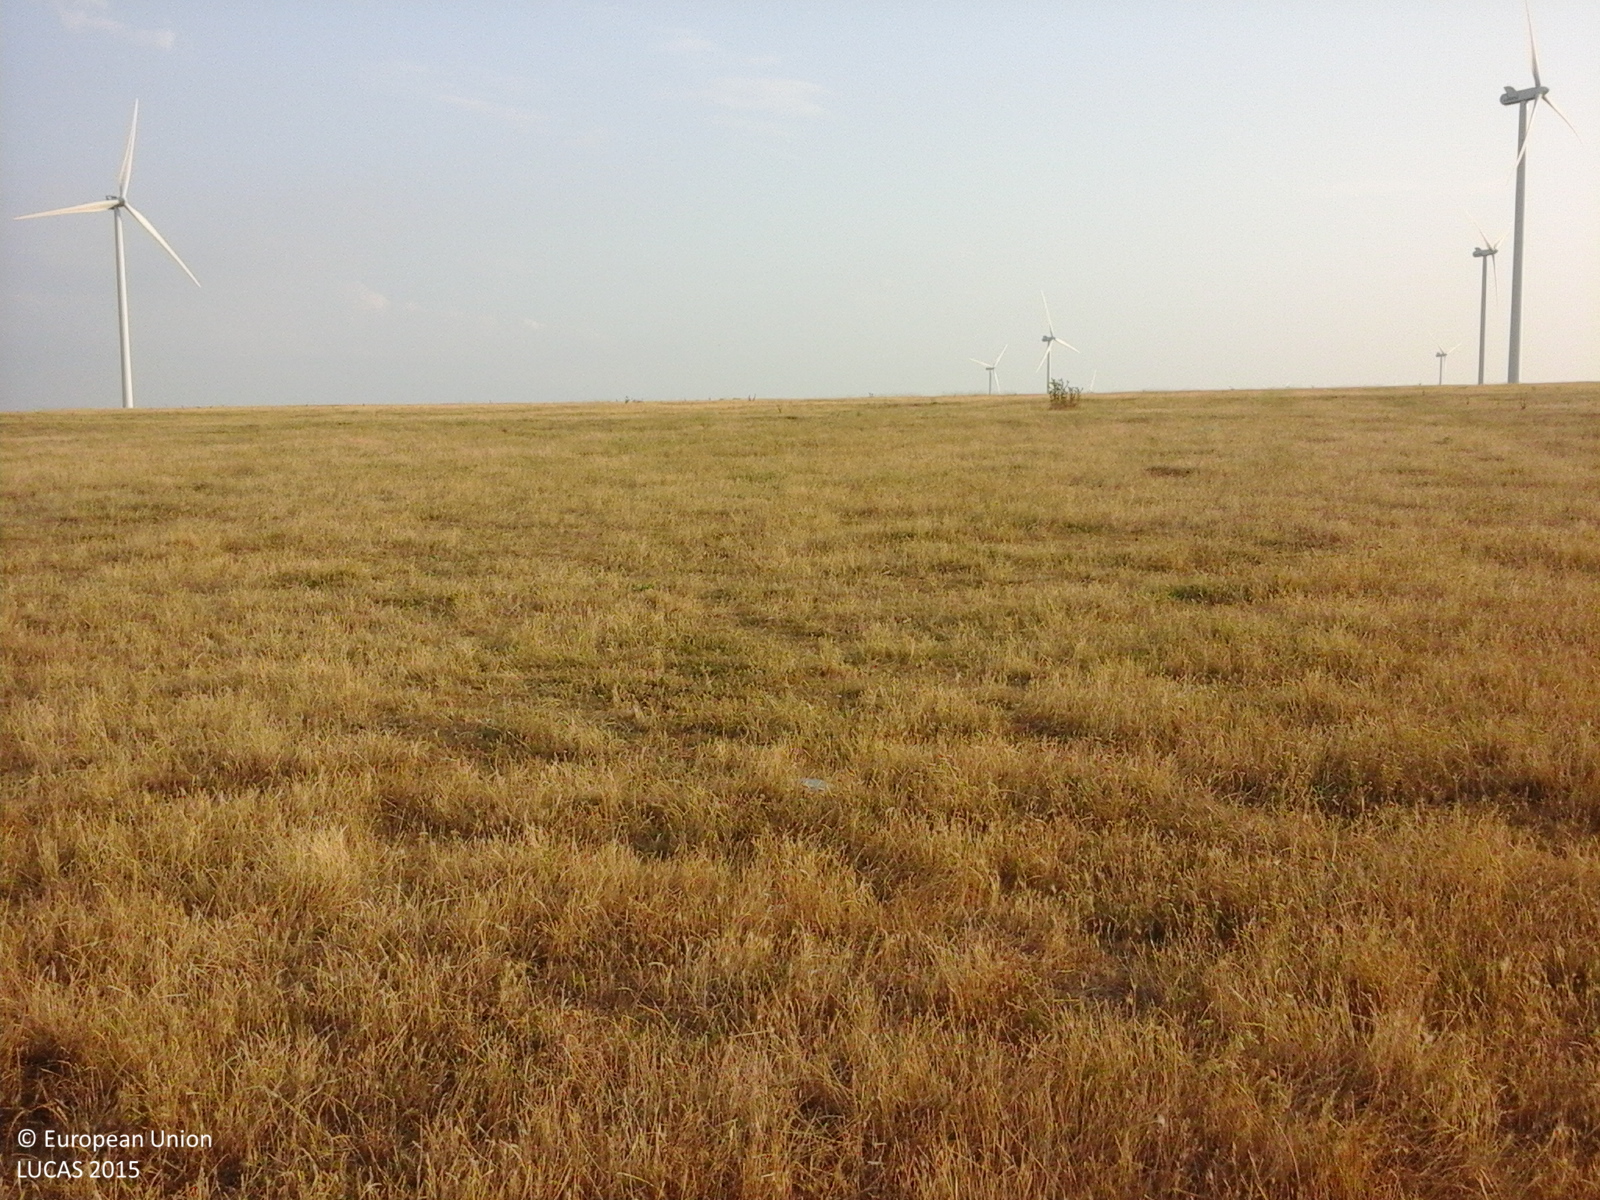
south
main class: Grassland
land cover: Grassland without tree/shrub cover
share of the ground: > 75 %
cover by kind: herbaceous plants 100 %
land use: Agriculture (excluding fallow land and kitchen gardens)
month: July
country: RO
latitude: 44.9075
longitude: 28.3748
